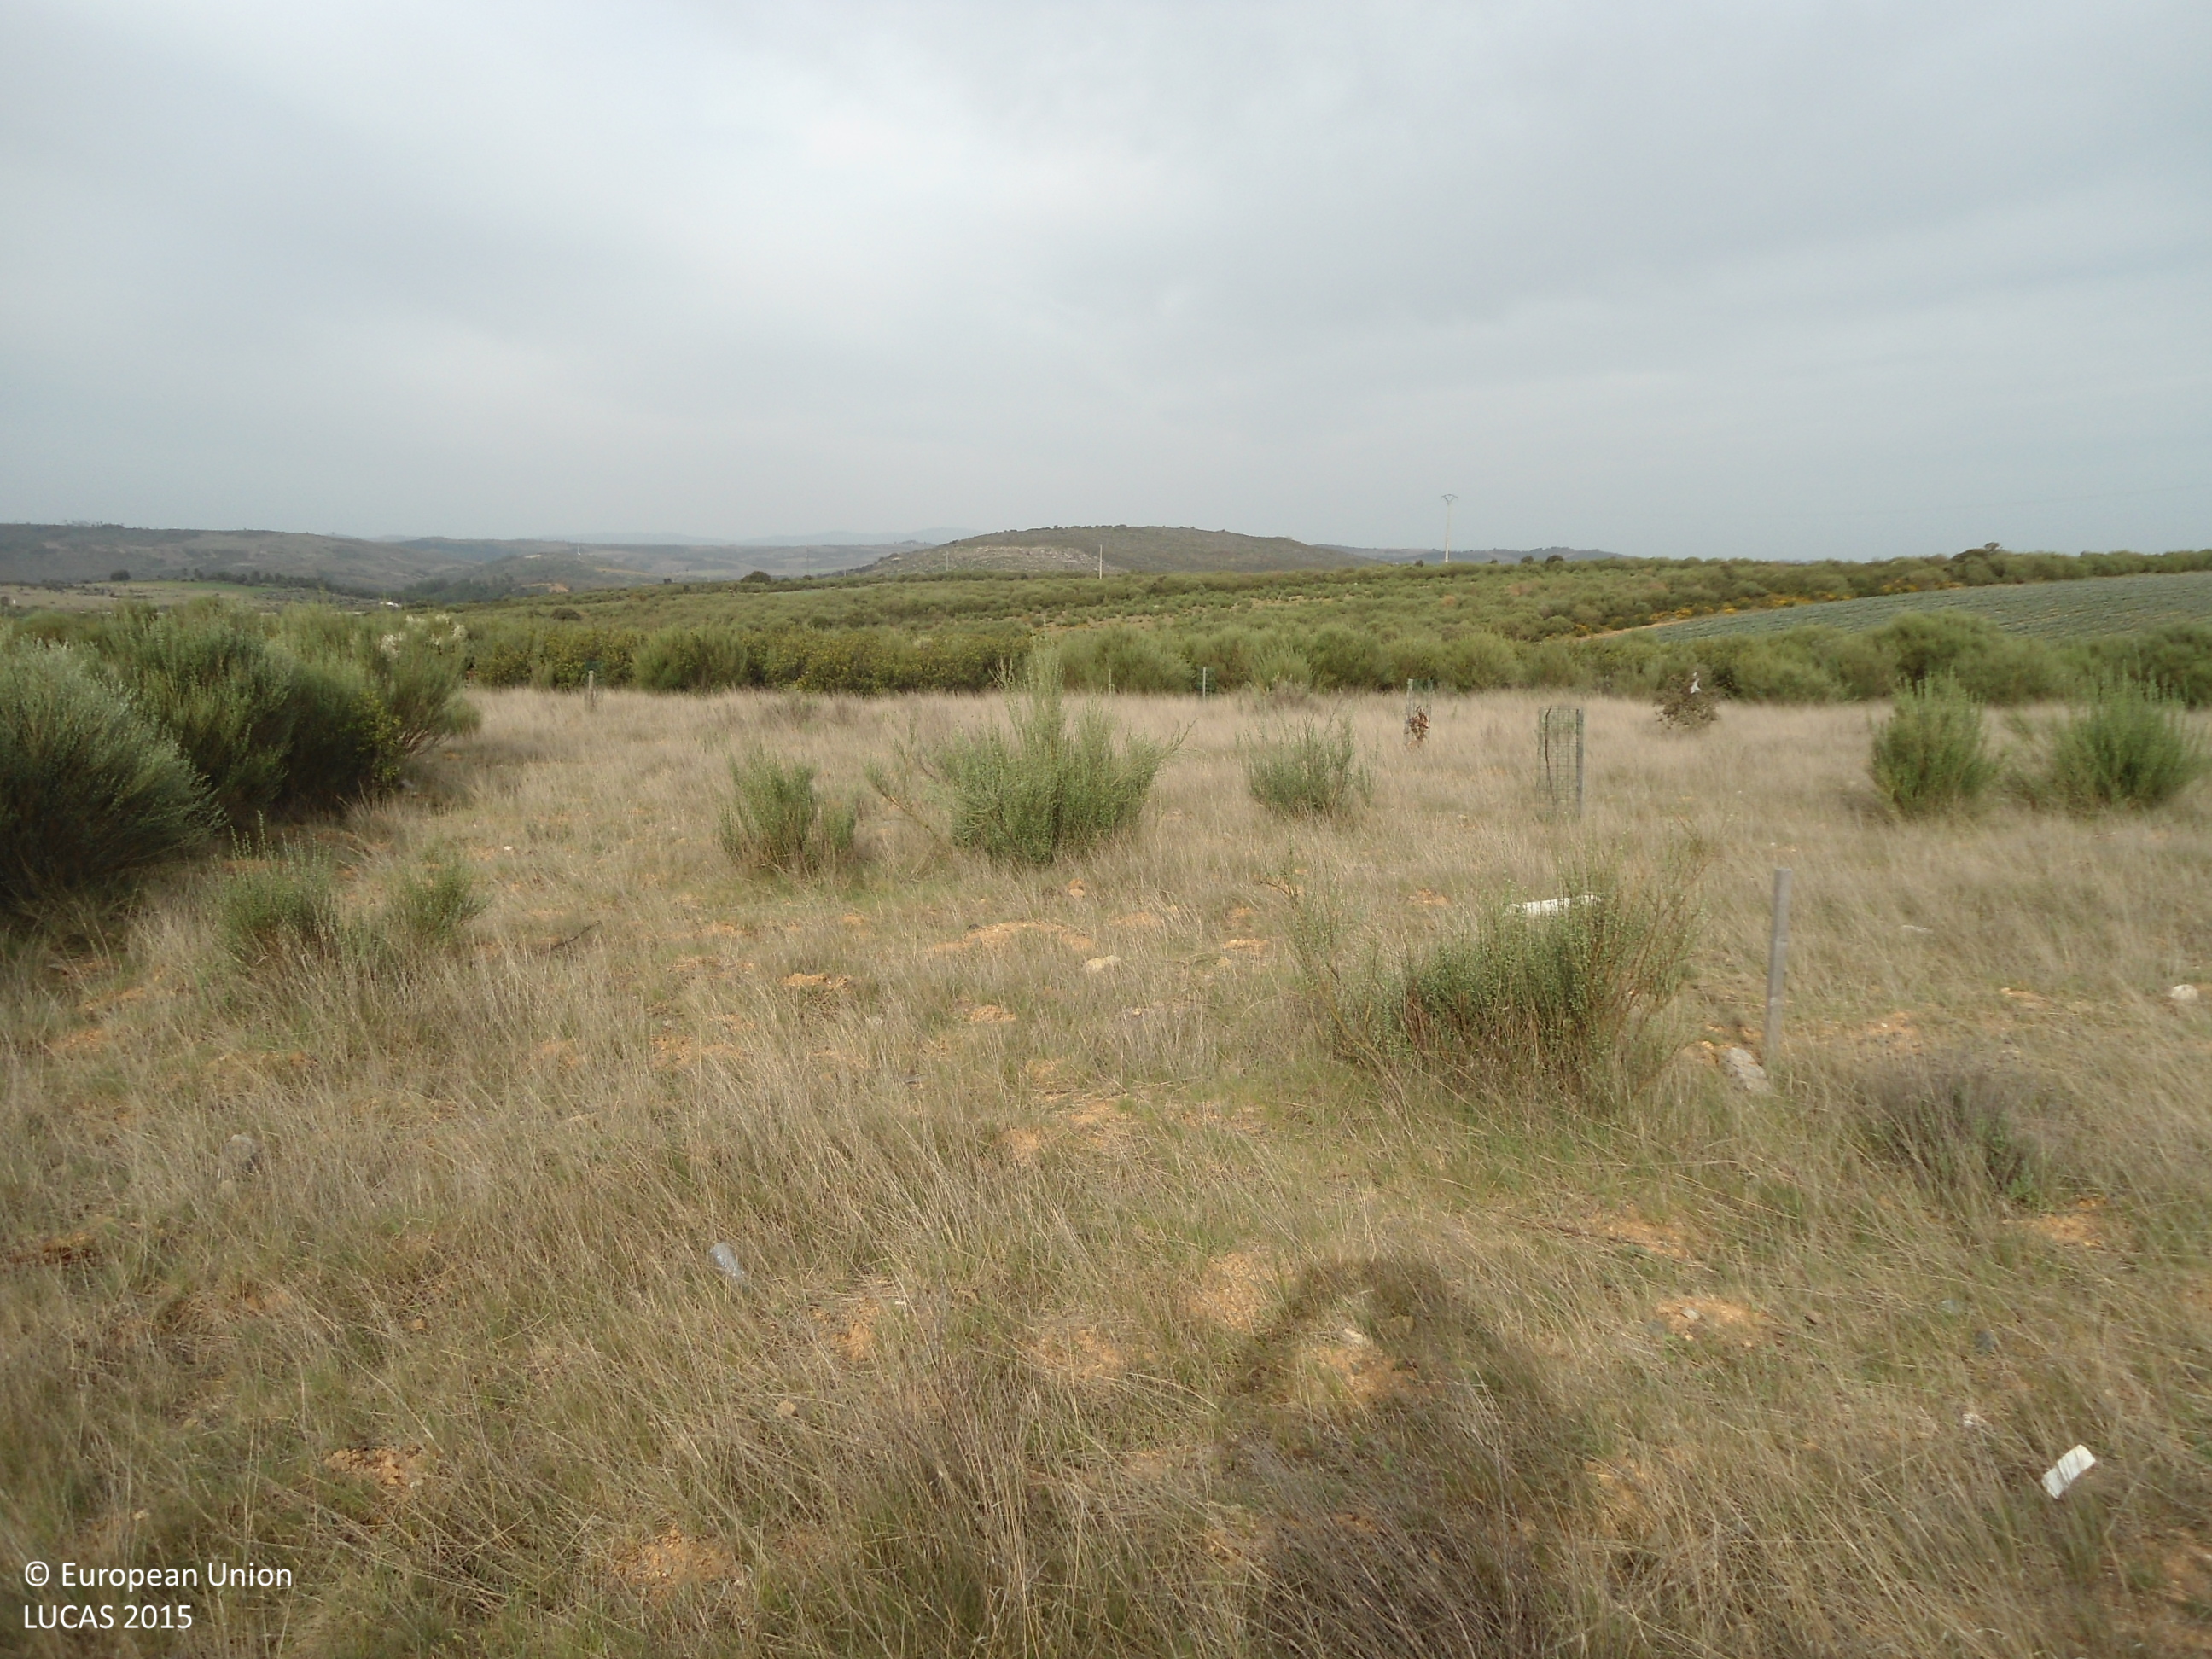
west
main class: Cropland
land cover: Nuts trees
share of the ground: < 10 %
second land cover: Shrubland without tree cover
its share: 50 - 75 %
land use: Abandoned areas
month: April
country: ES
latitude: 41.7462
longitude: -6.5211
